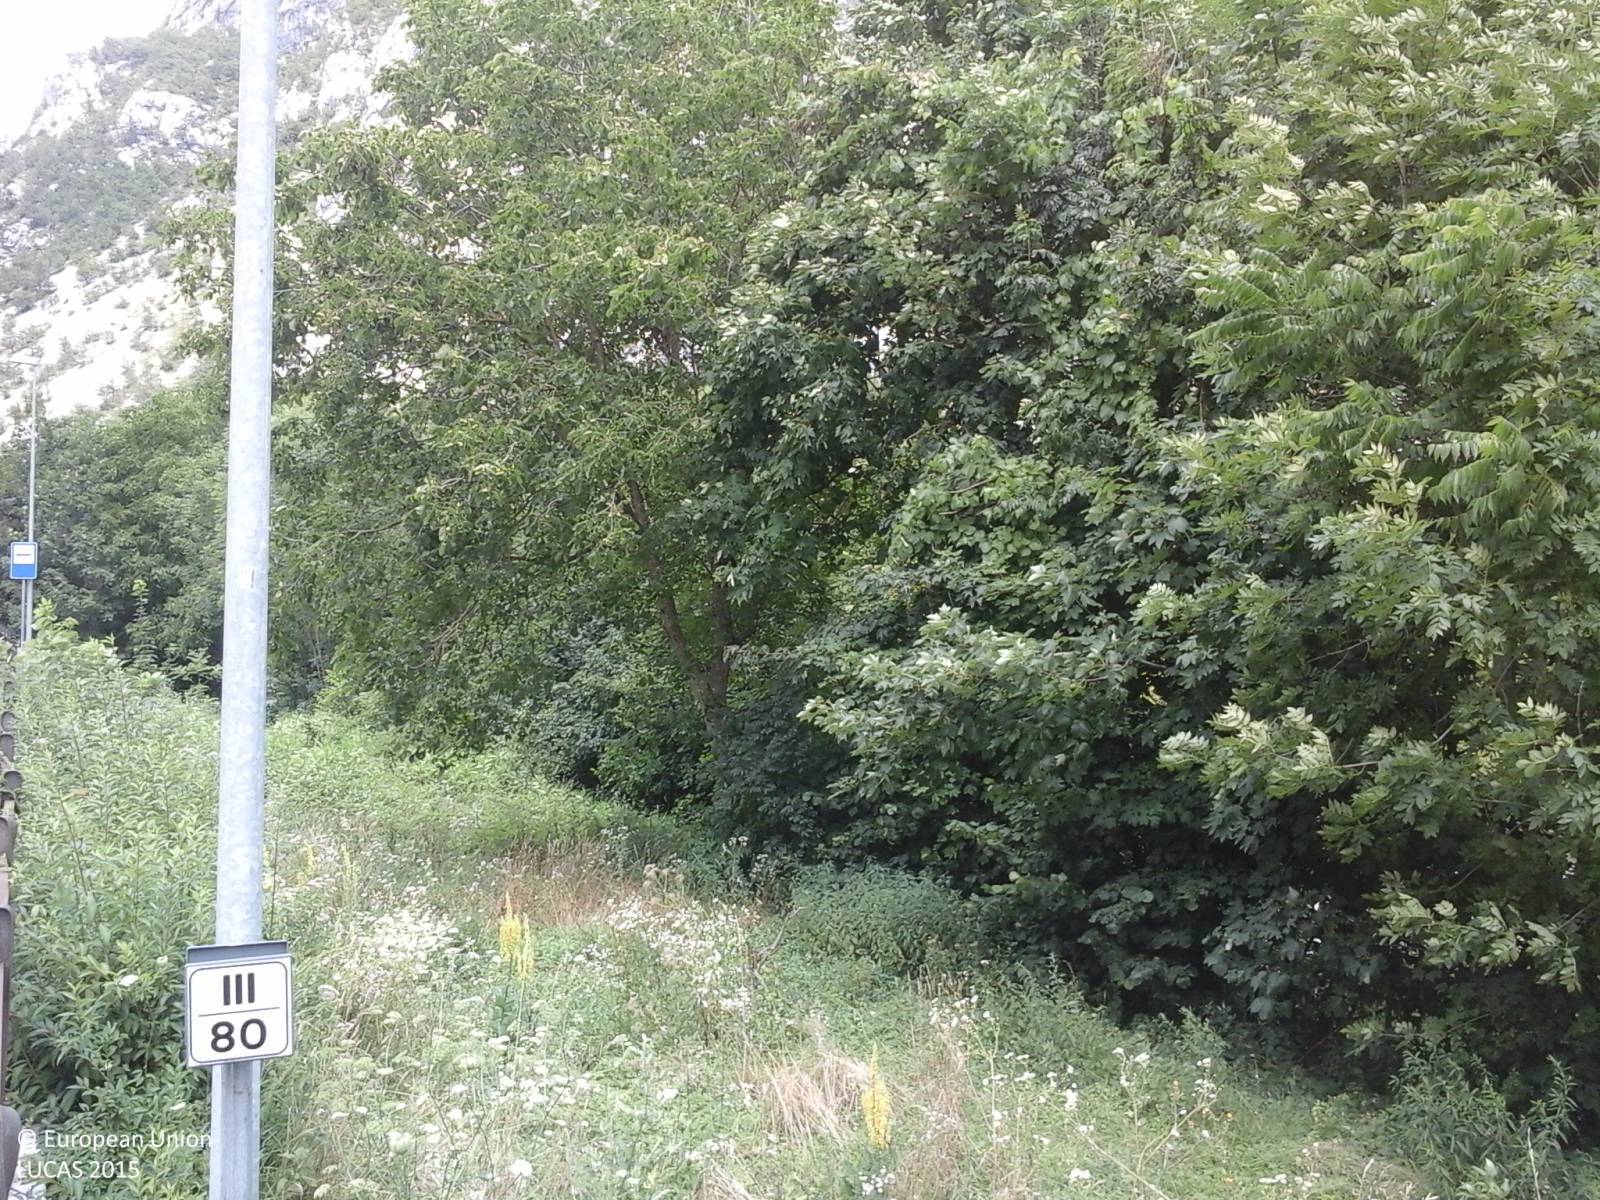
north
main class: Woodland
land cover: Broadleaved woodland
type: mountainous beech forest
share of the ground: > 75 %
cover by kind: broadleaved forest trees 80 %, coniferous forest trees 20 %
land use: Semi-natural and natural areas not in use
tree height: > 5 m
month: July
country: IT
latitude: 46.2505
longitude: 12.4746
